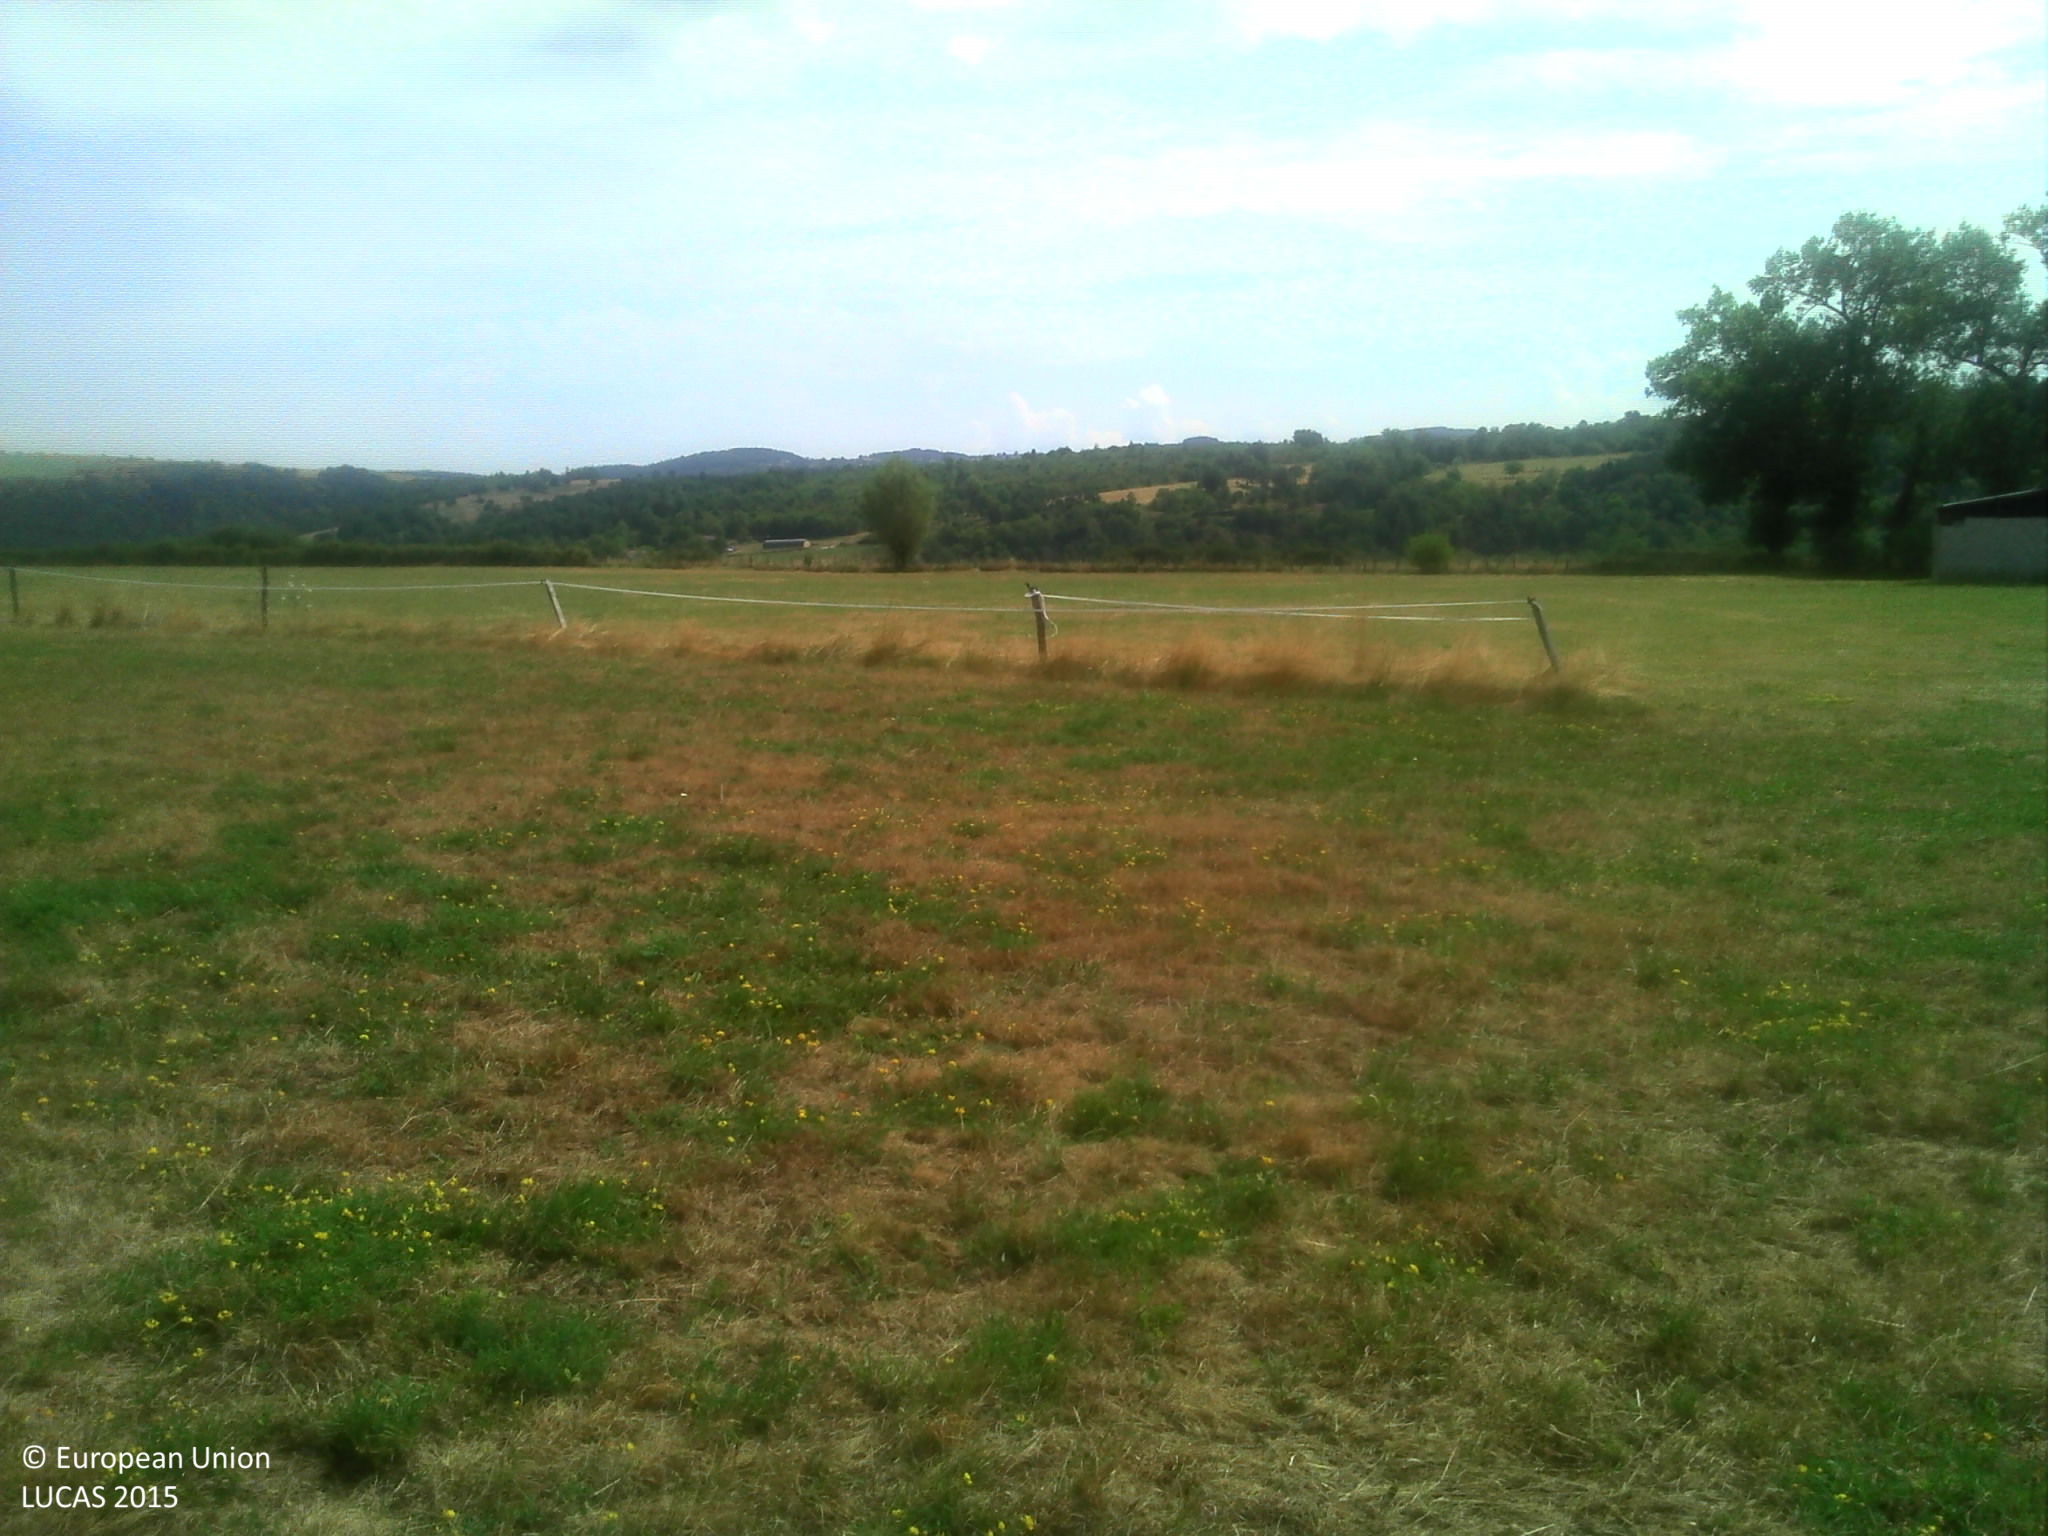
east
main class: Grassland
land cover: Grassland without tree/shrub cover
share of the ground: > 75 %
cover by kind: herbaceous plants 100 %
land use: Agriculture (excluding fallow land and kitchen gardens)
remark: Harvested field
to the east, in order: Grassland without tree/shrub cover; Fences; Grassland without tree/shrub cover; Fences; Grass margins; Tracks; Grass margins; Fences; Grassland without tree/shrub cover; Fences; Grassland without tree/shrub cover; Fences; Grassland without tree/shrub cover
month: July
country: FR
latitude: 45.3240
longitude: 4.1478
